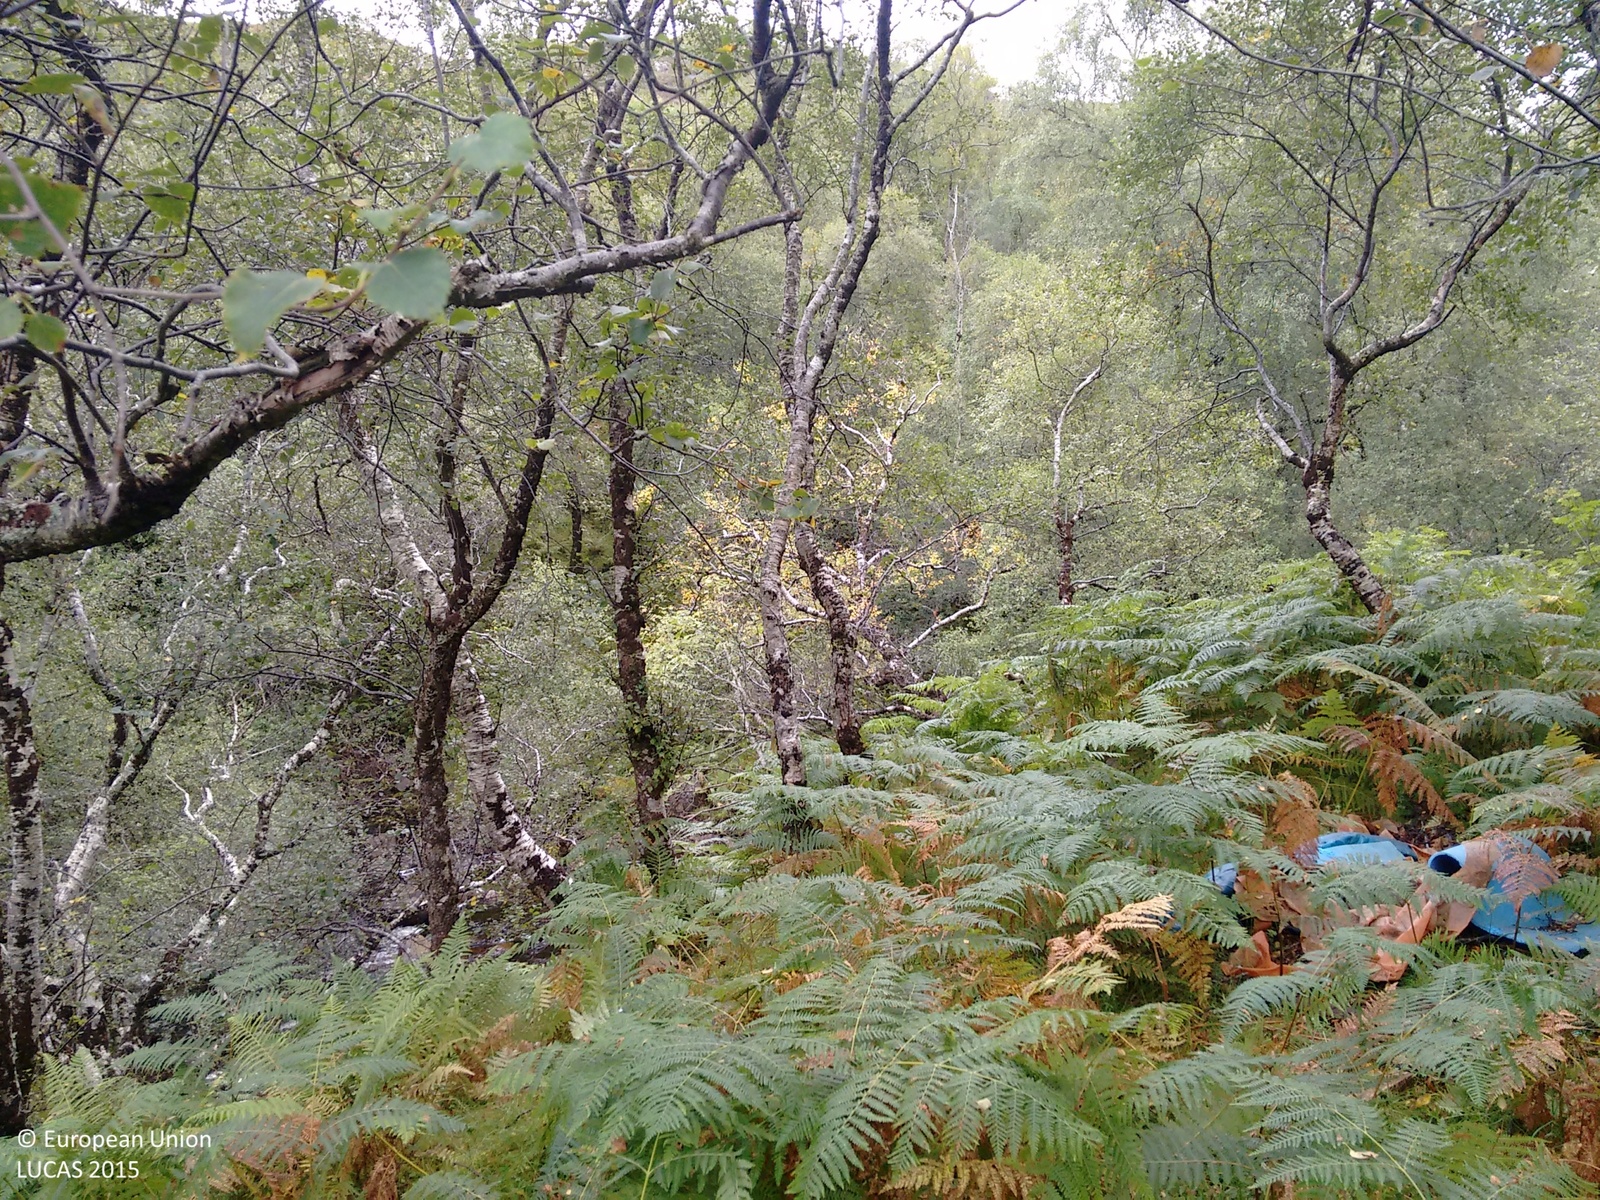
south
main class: Woodland
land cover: Broadleaved woodland
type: floodplain forest
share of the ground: > 75 %
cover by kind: broadleaved forest trees 90 %, herbaceous plants 10 %
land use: Agriculture (excluding fallow land and kitchen gardens)
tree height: > 5 m
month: September
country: GB
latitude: 57.5268
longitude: -5.7007
